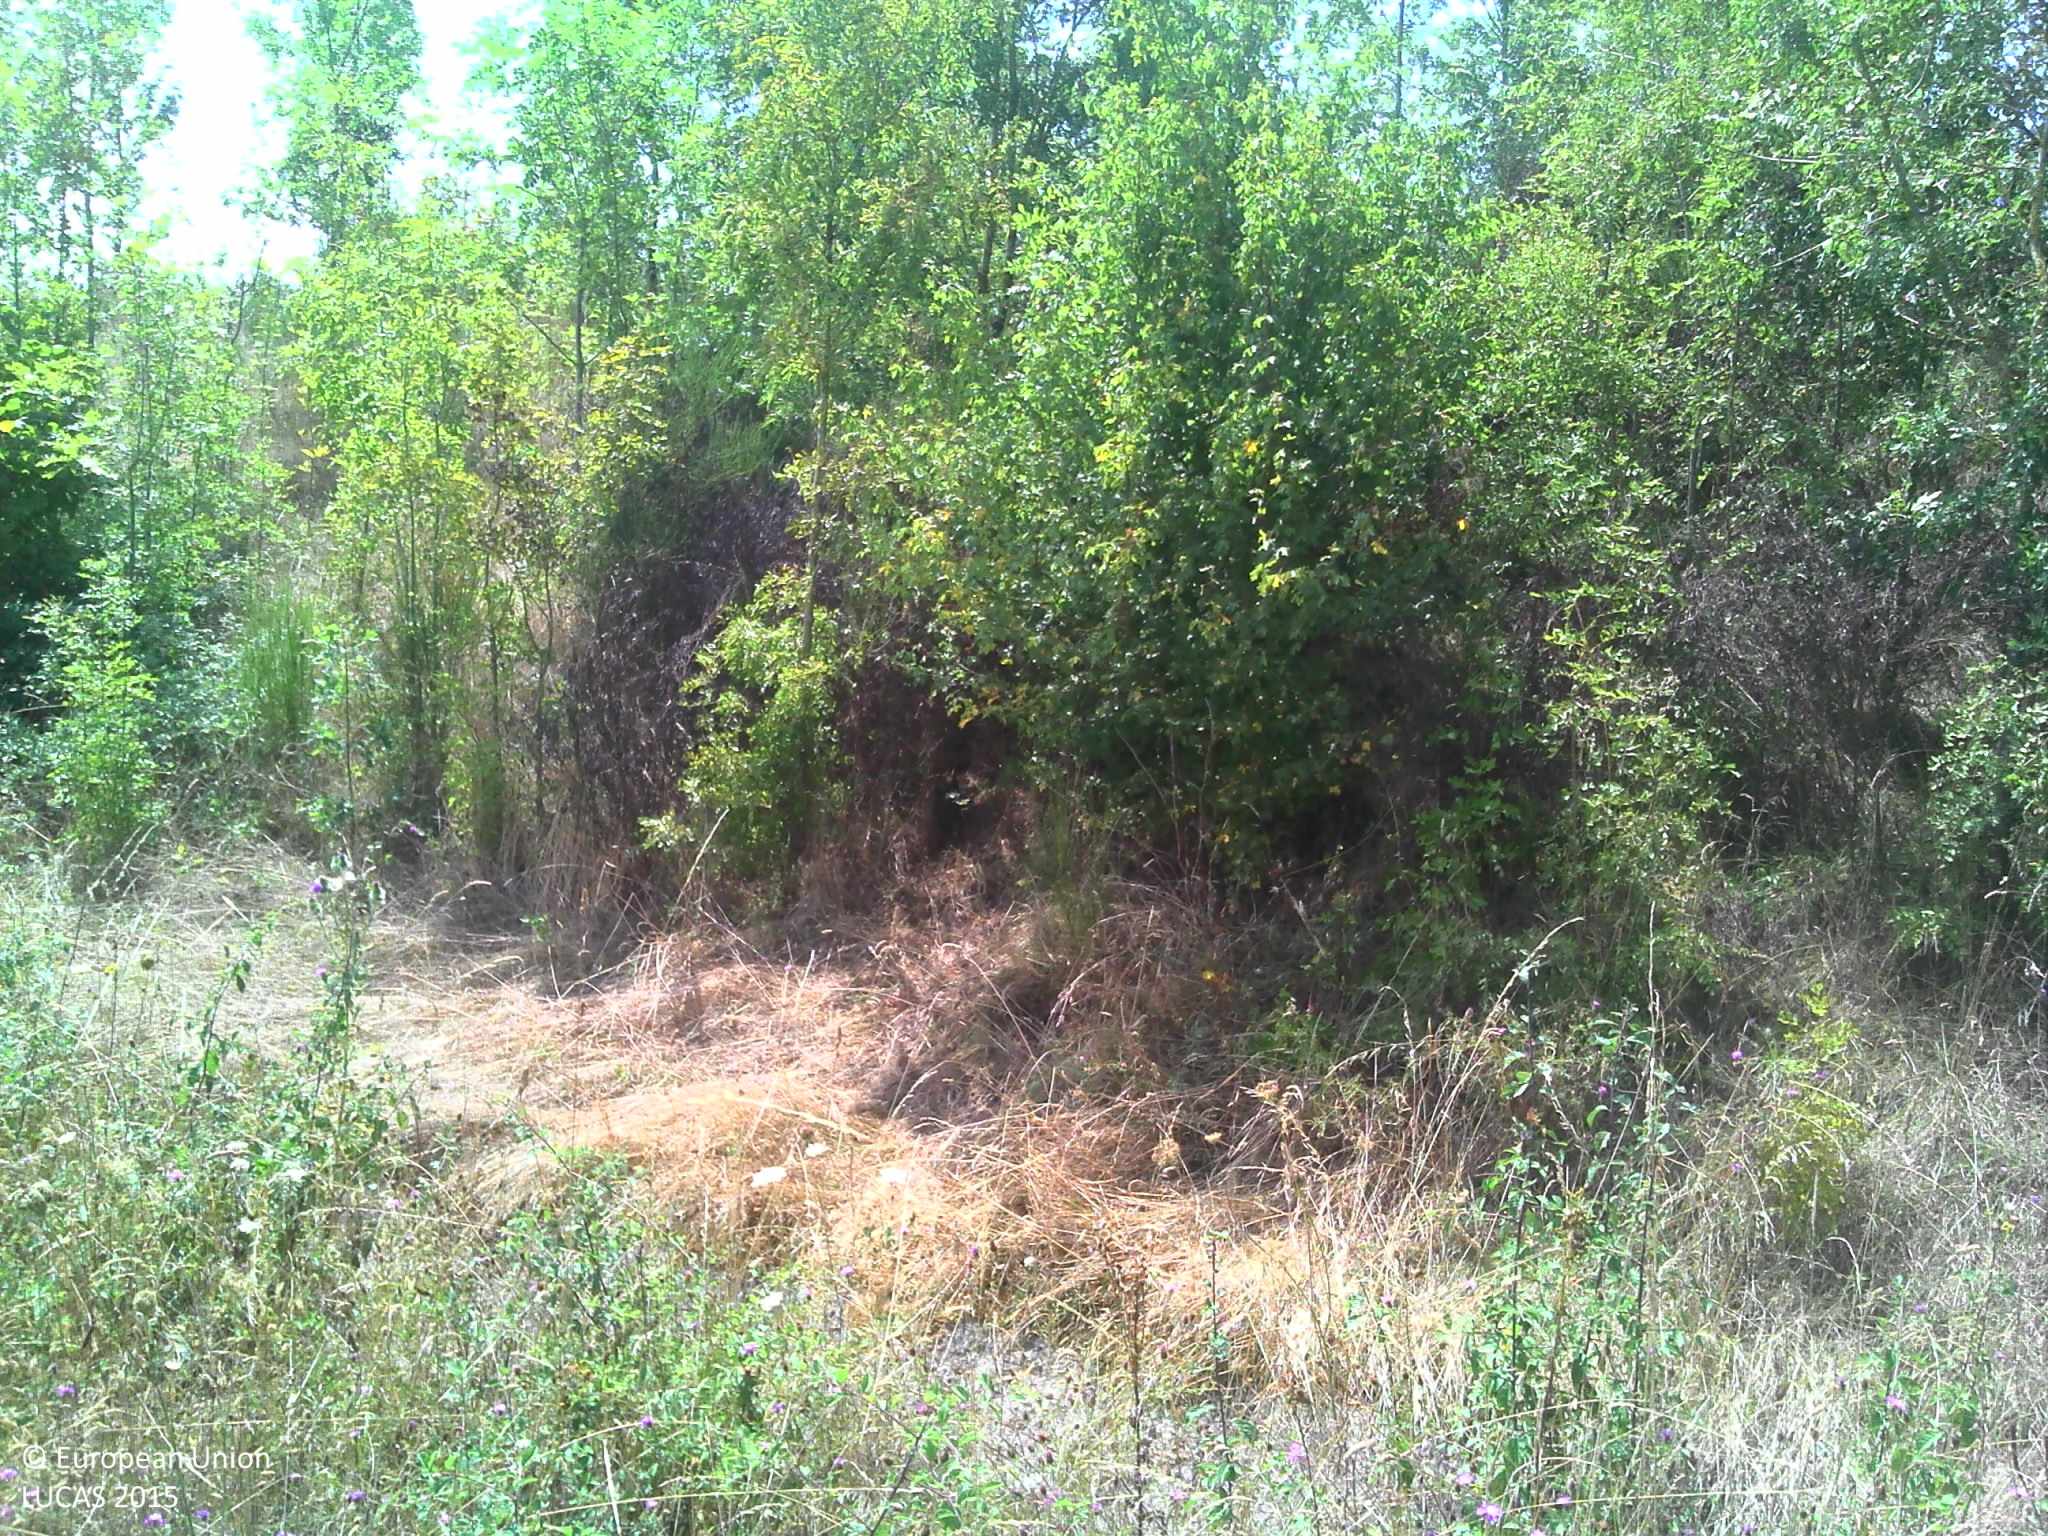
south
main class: Woodland
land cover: Broadleaved woodland
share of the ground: > 75 %
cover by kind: broadleaved forest trees 90 %, shrubs 10 %
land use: Road transport
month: August
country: FR
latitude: 46.6563
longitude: -1.1551
